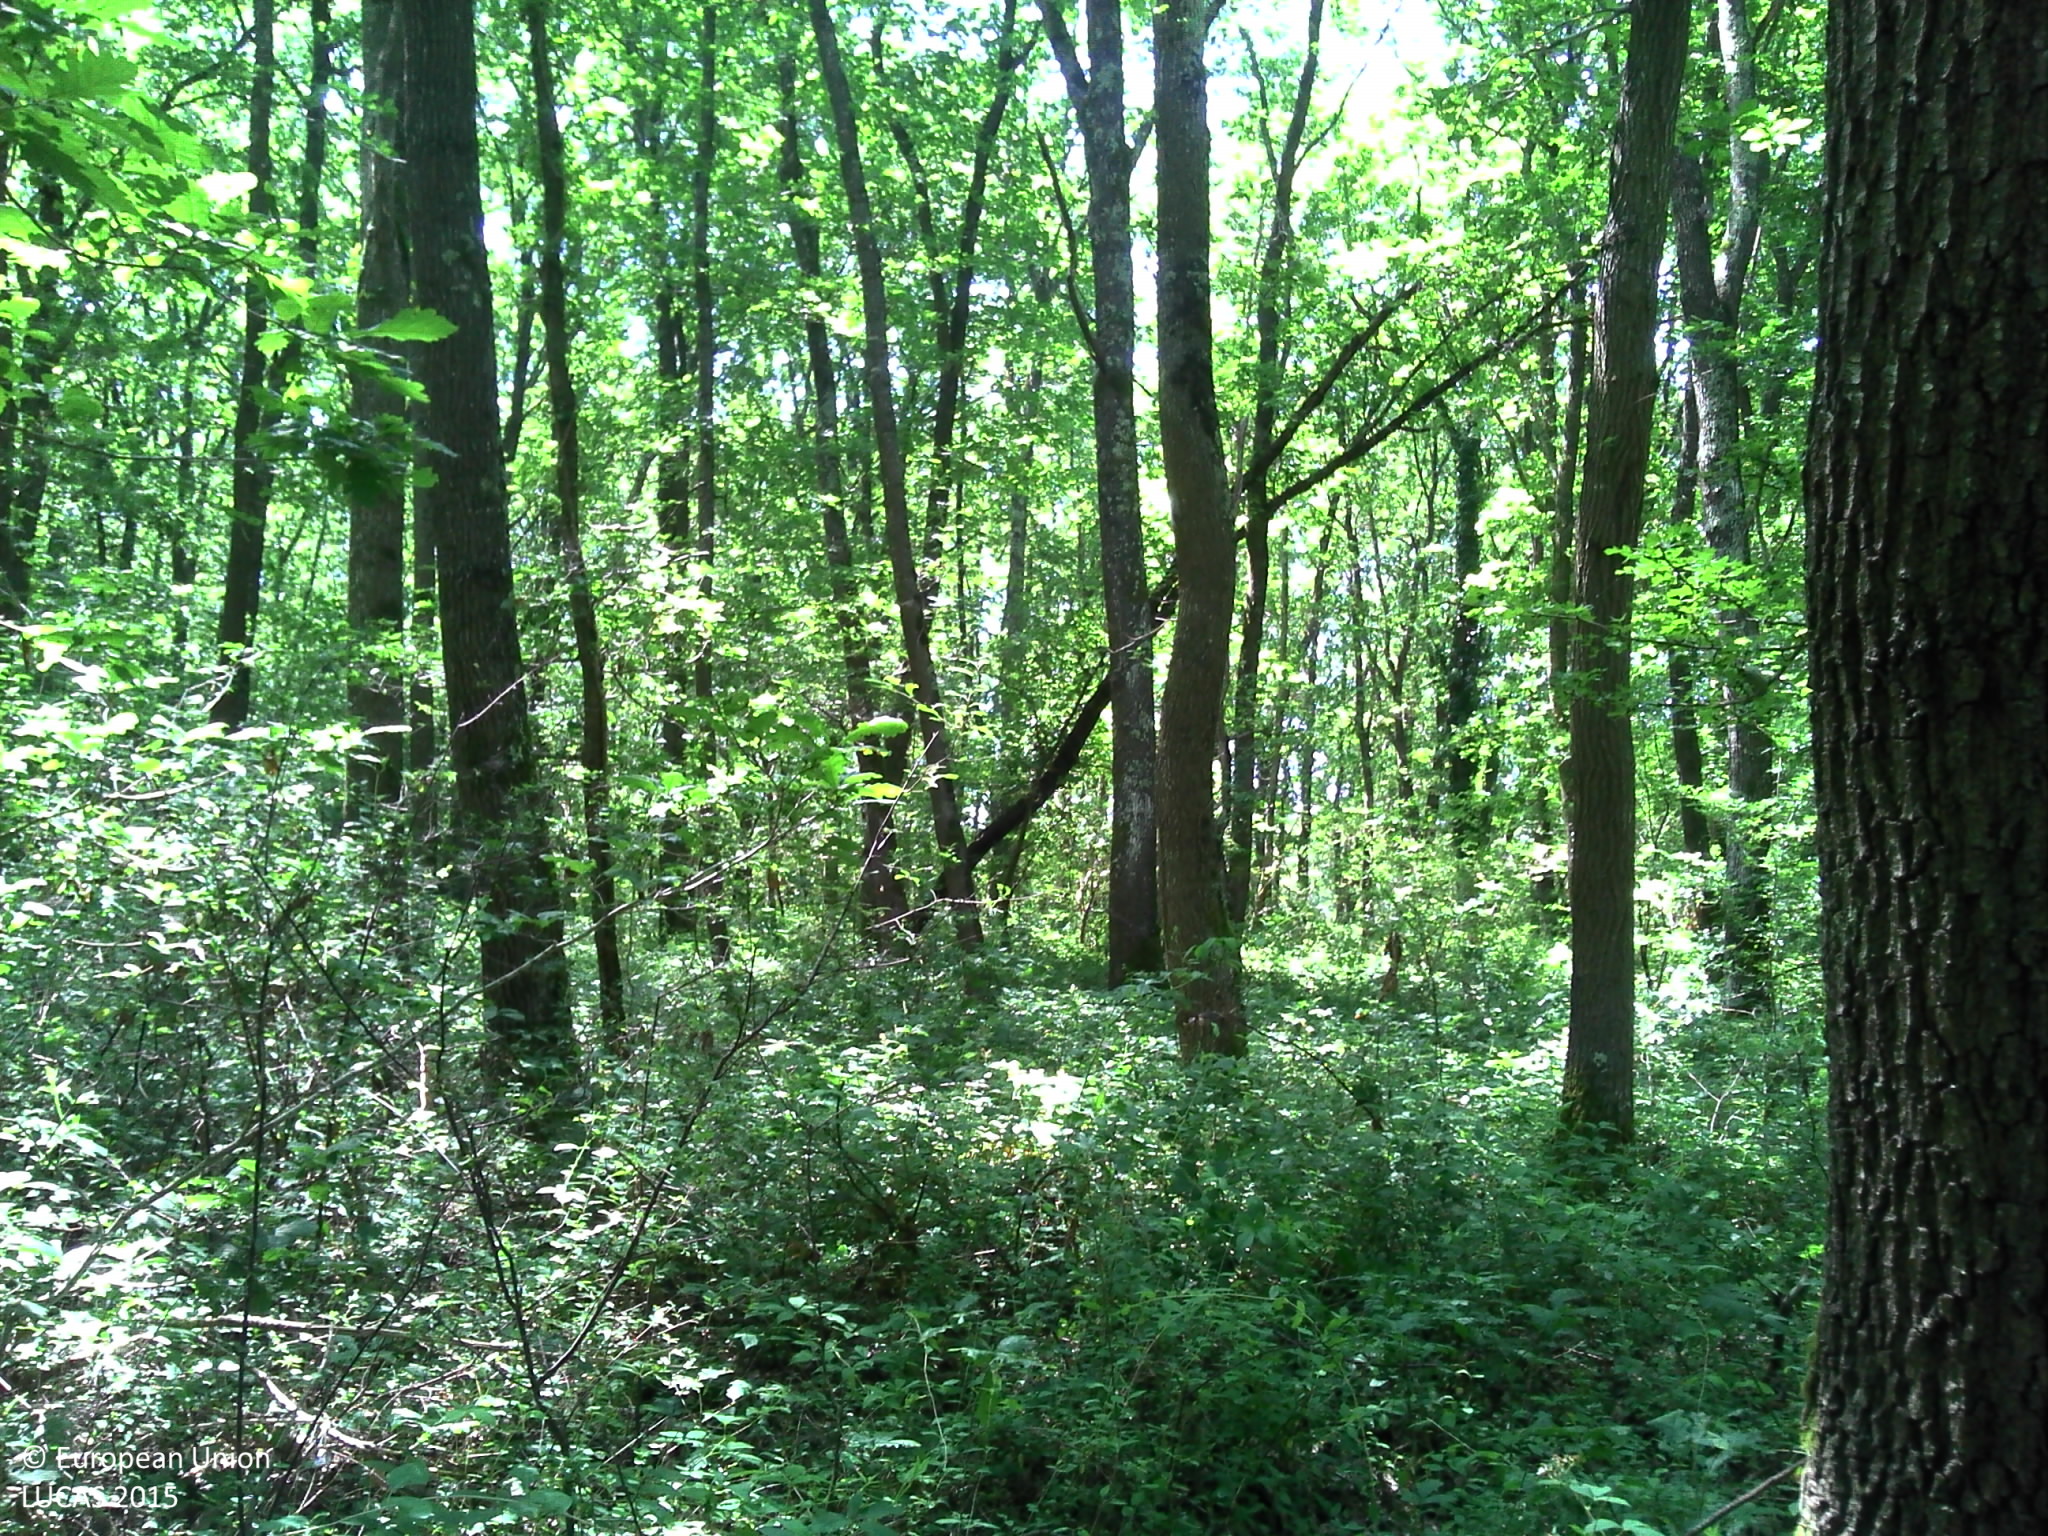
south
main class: Woodland
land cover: Broadleaved woodland
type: acidophilous oak and oak-birch forest
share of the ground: > 75 %
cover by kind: broadleaved forest trees 90 %, shrubs 5 %, herbaceous plants 5 %
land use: Forestry
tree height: > 5 m
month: June
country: FR
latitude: 46.2523
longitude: 3.3447
